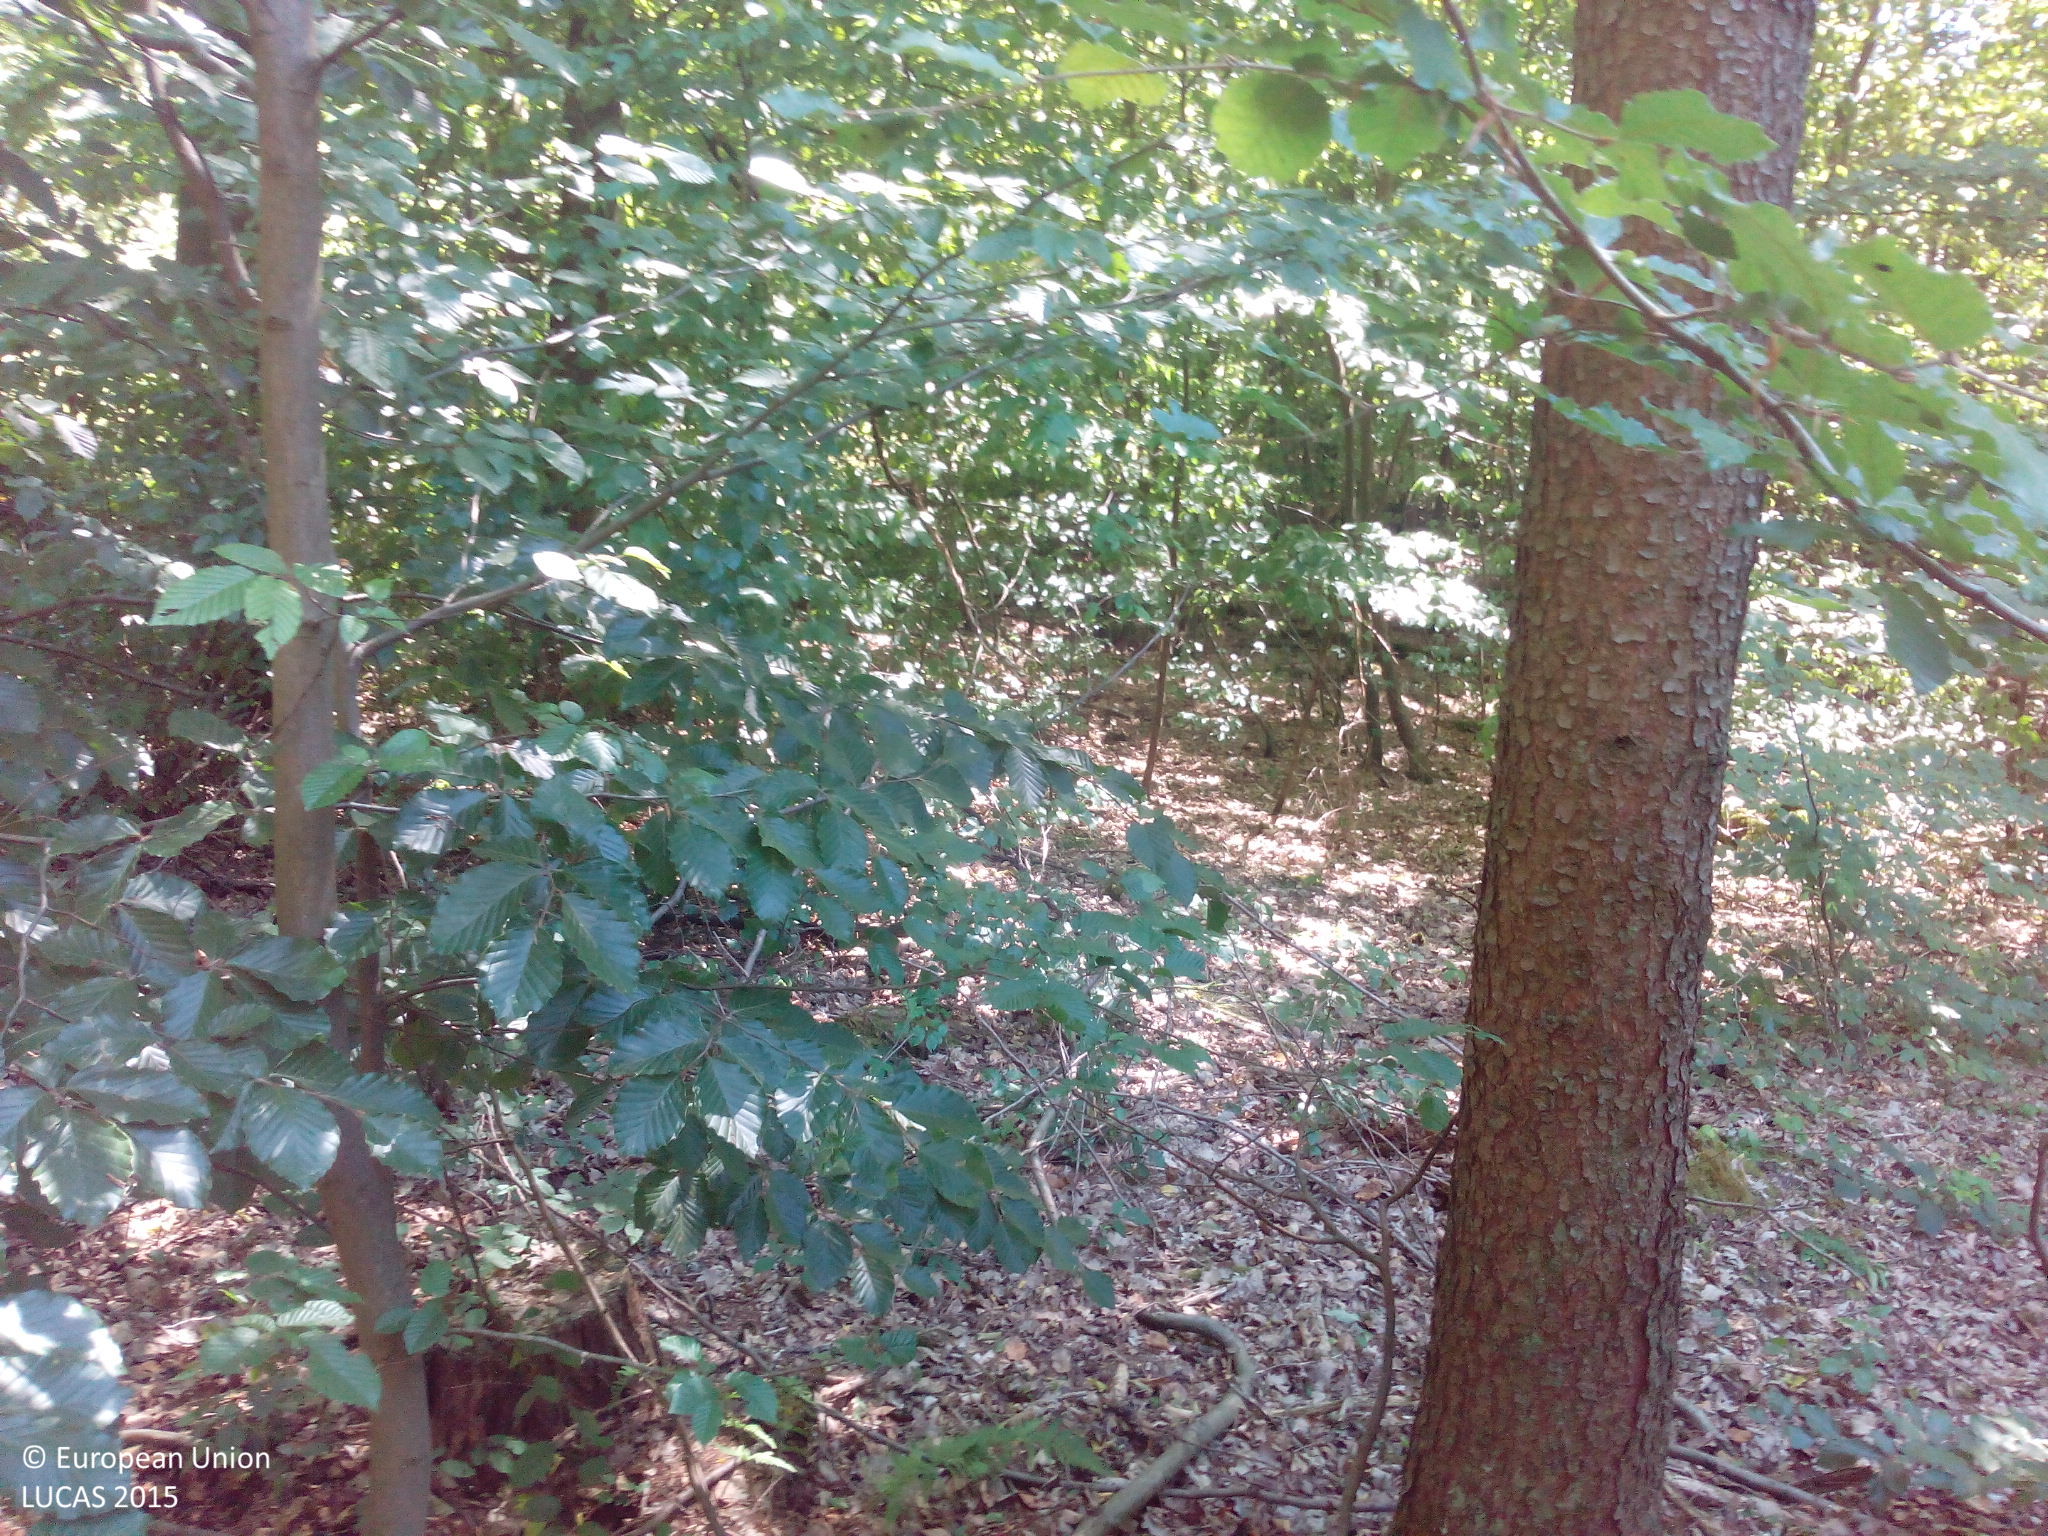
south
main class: Woodland
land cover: Pine dominated mixed woodland
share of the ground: 50 - 75 %
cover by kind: broadleaved forest trees 30 %, coniferous forest trees 25 %, unconsolidated bare surface 25 %, shrubs 20 %
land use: Forestry
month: July
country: DE
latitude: 49.6253
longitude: 10.5674
